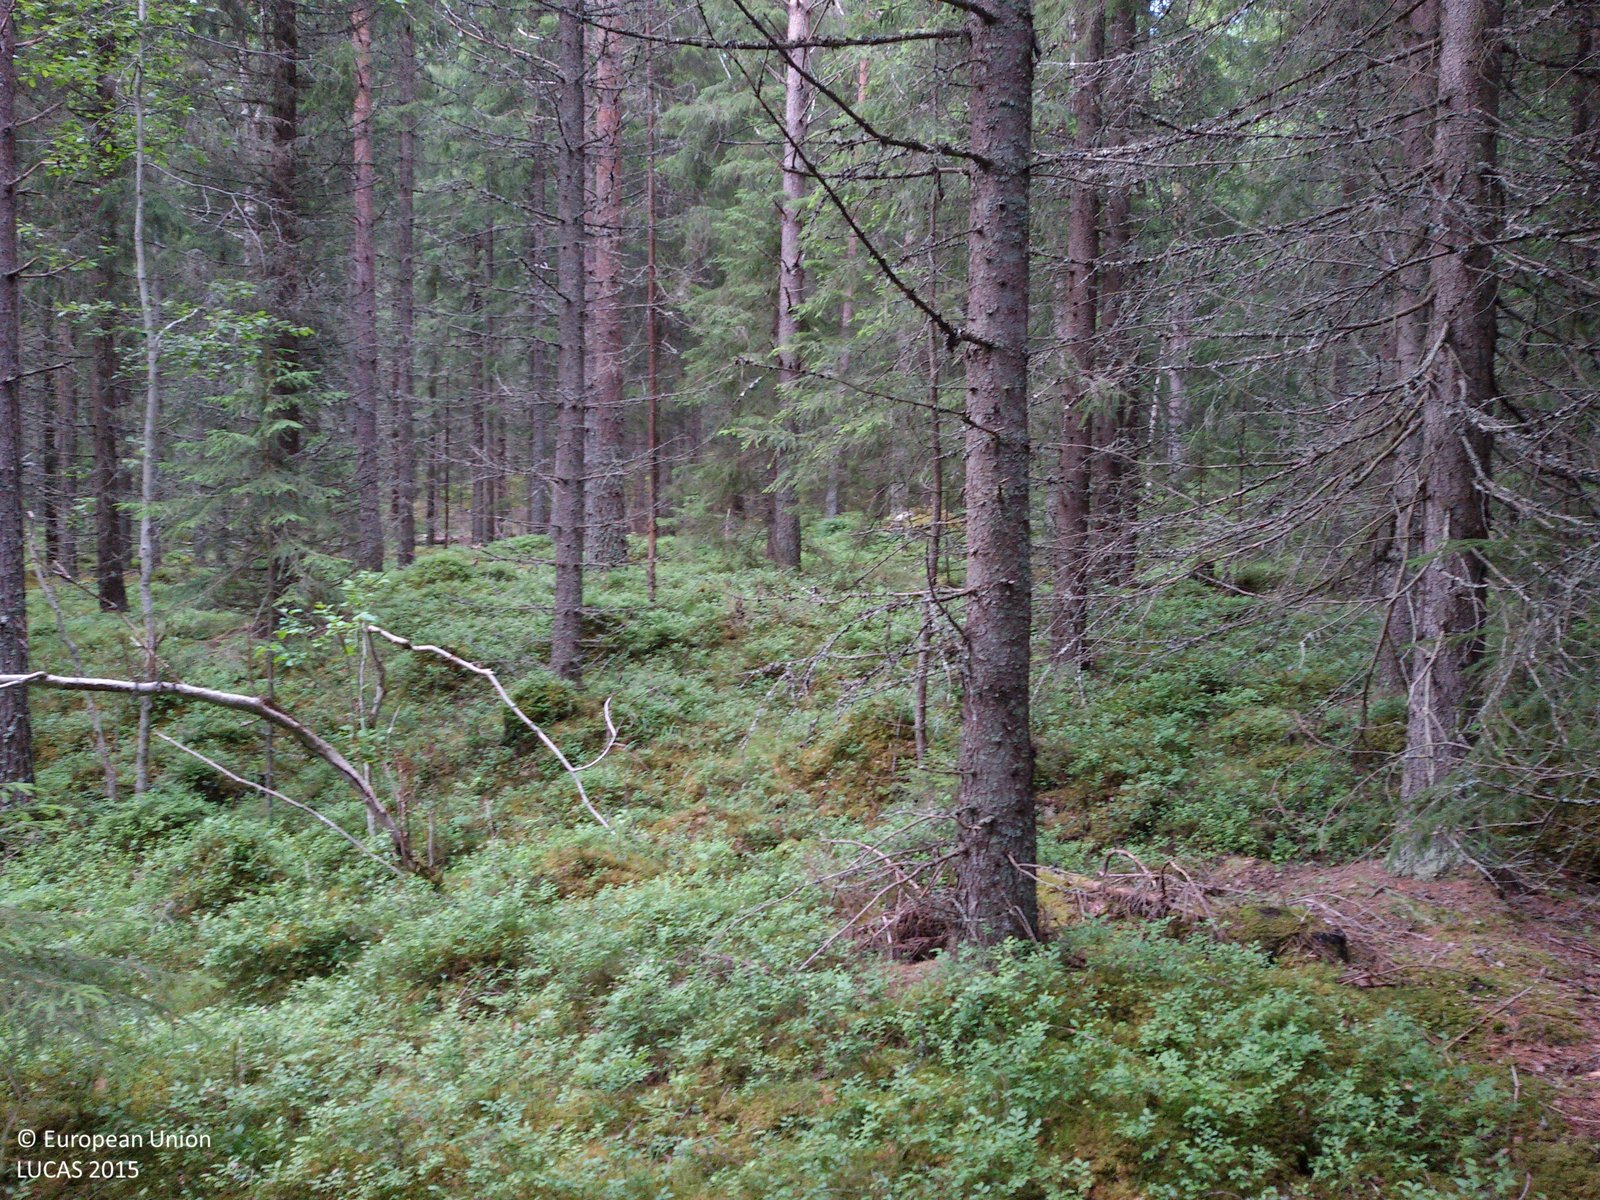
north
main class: Woodland
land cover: Spruce dominated coniferous woodland
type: boreal forest
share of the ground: > 75 %
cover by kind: coniferous forest trees 80 %, herbaceous plants 10 %, lichens and mosses 10 %
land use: Forestry
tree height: > 5 m
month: July
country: SE
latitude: 60.3649
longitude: 14.9378
